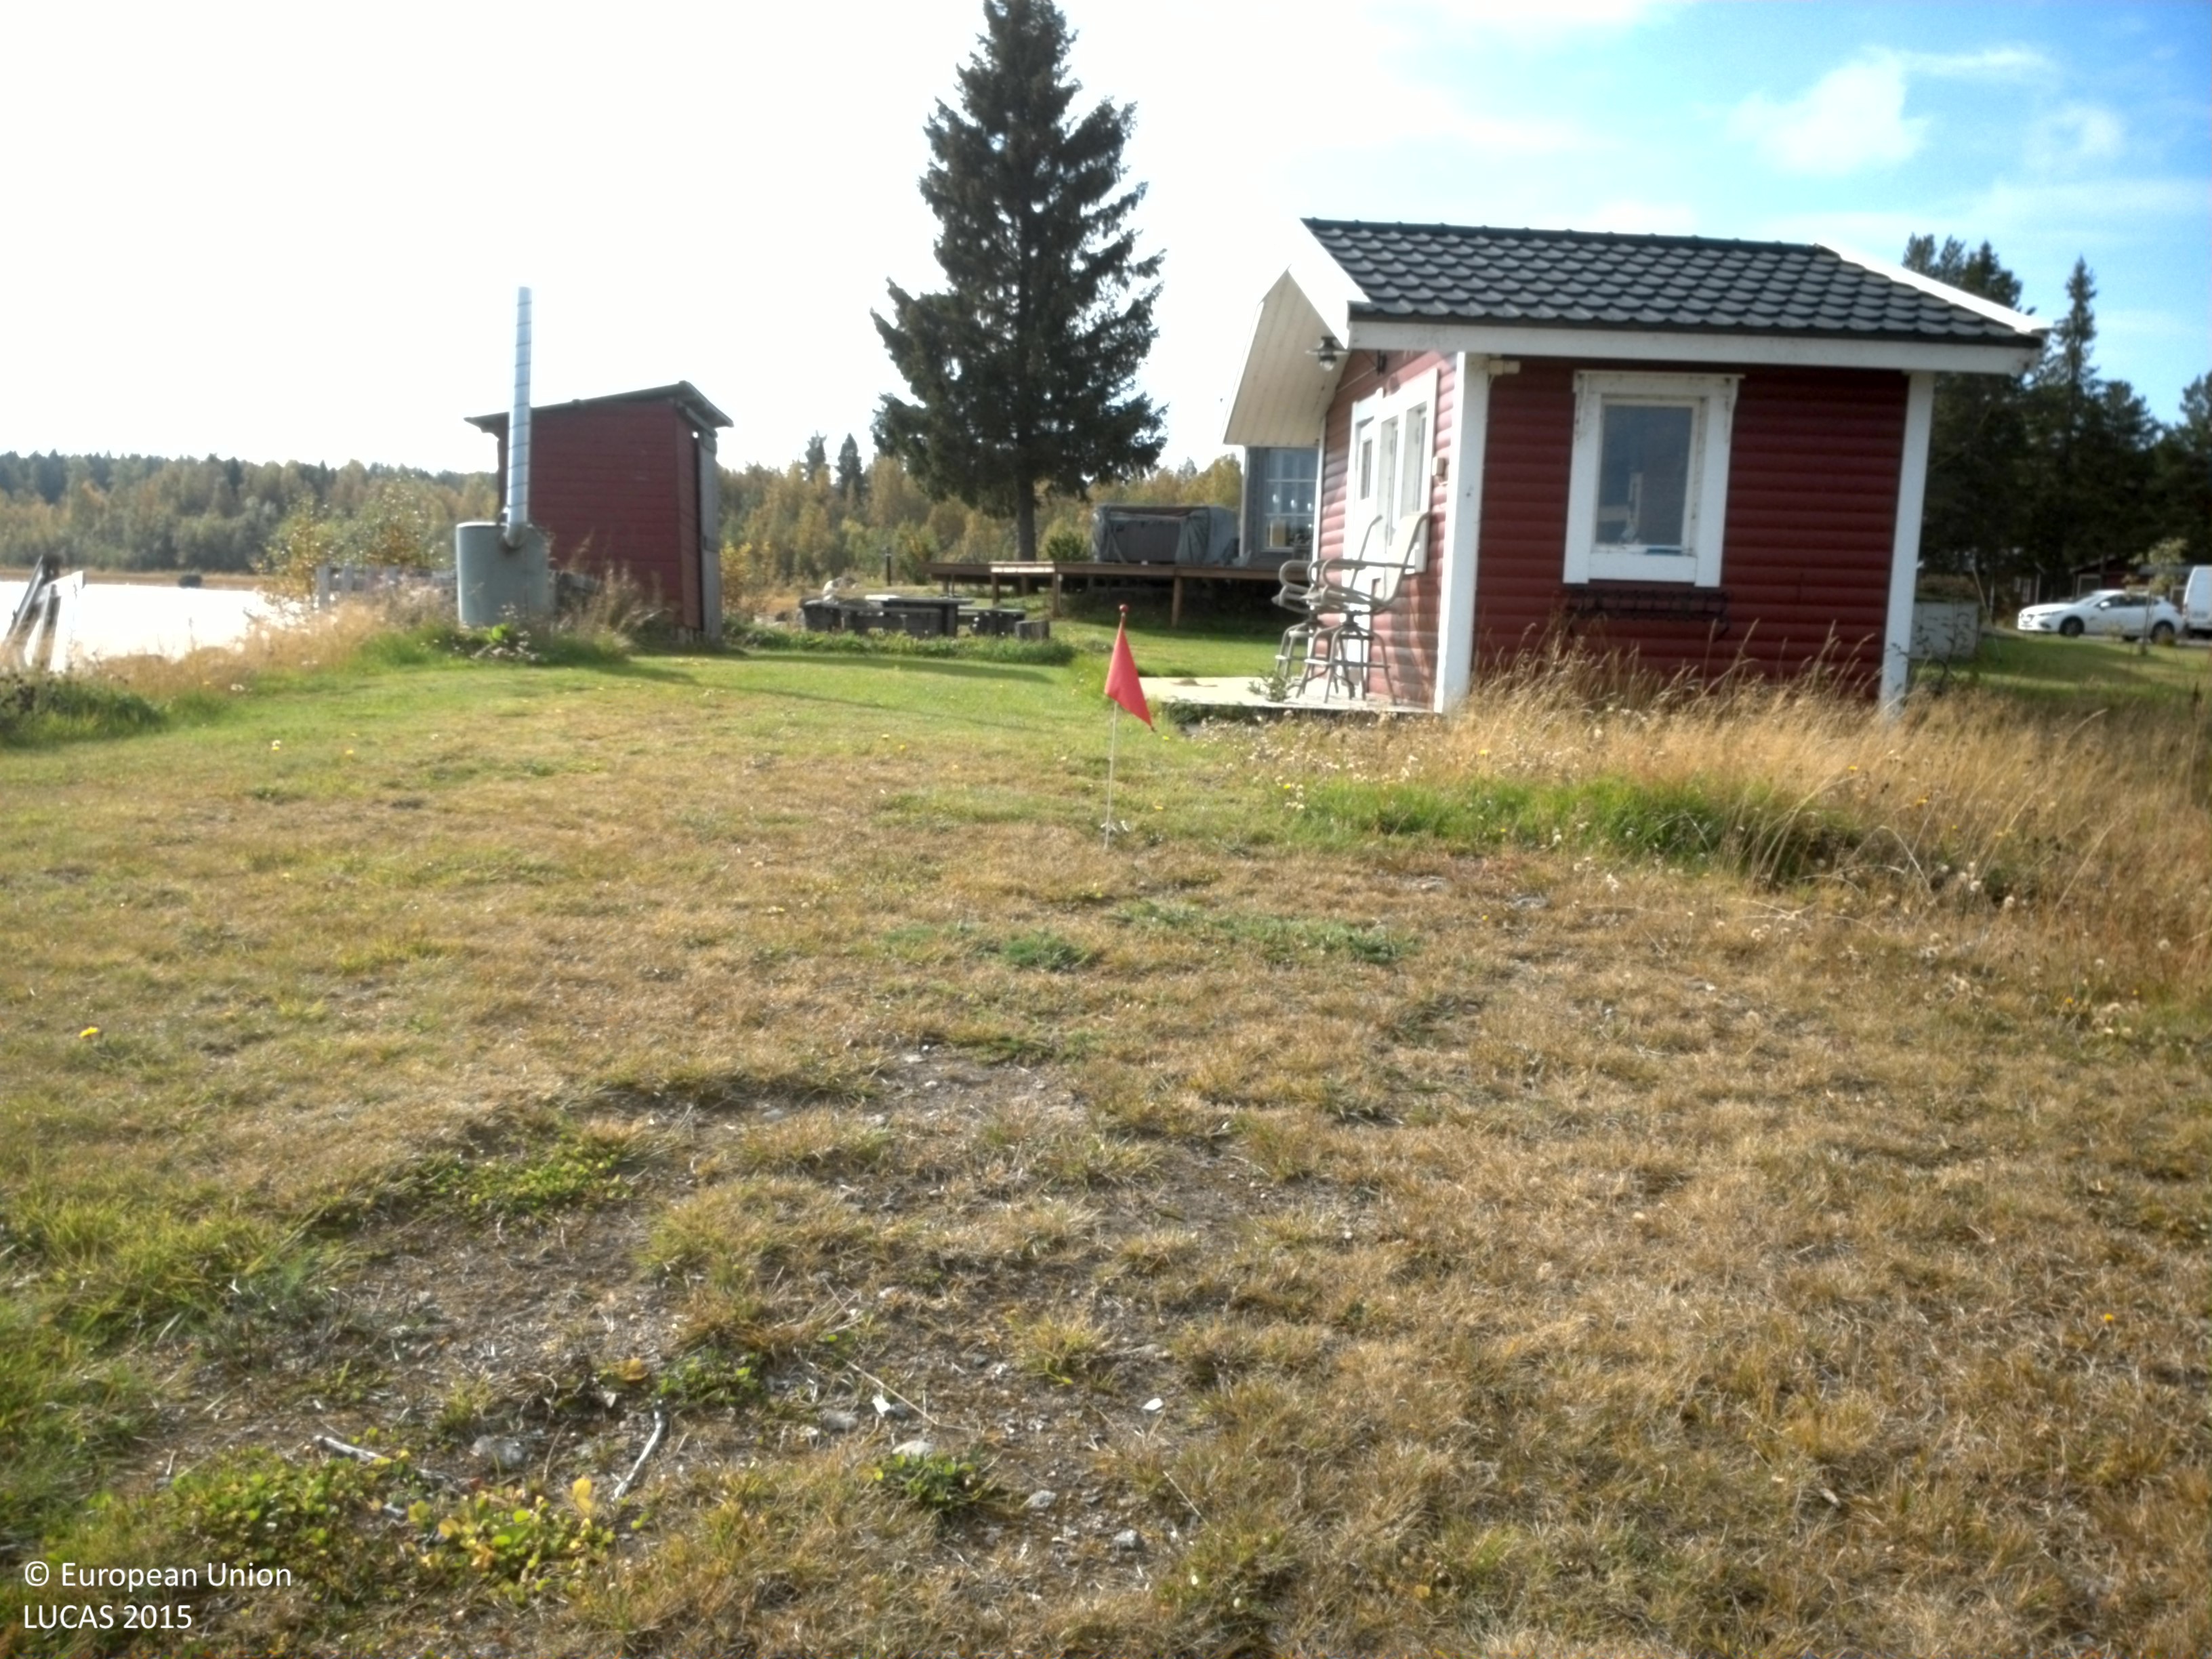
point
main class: Grassland
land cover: Grassland without tree/shrub cover
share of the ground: > 75 %
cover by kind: herbaceous plants 100 %
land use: Residential
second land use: Amenities, museums, leisure
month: September
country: SE
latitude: 65.4325
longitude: 21.8991
